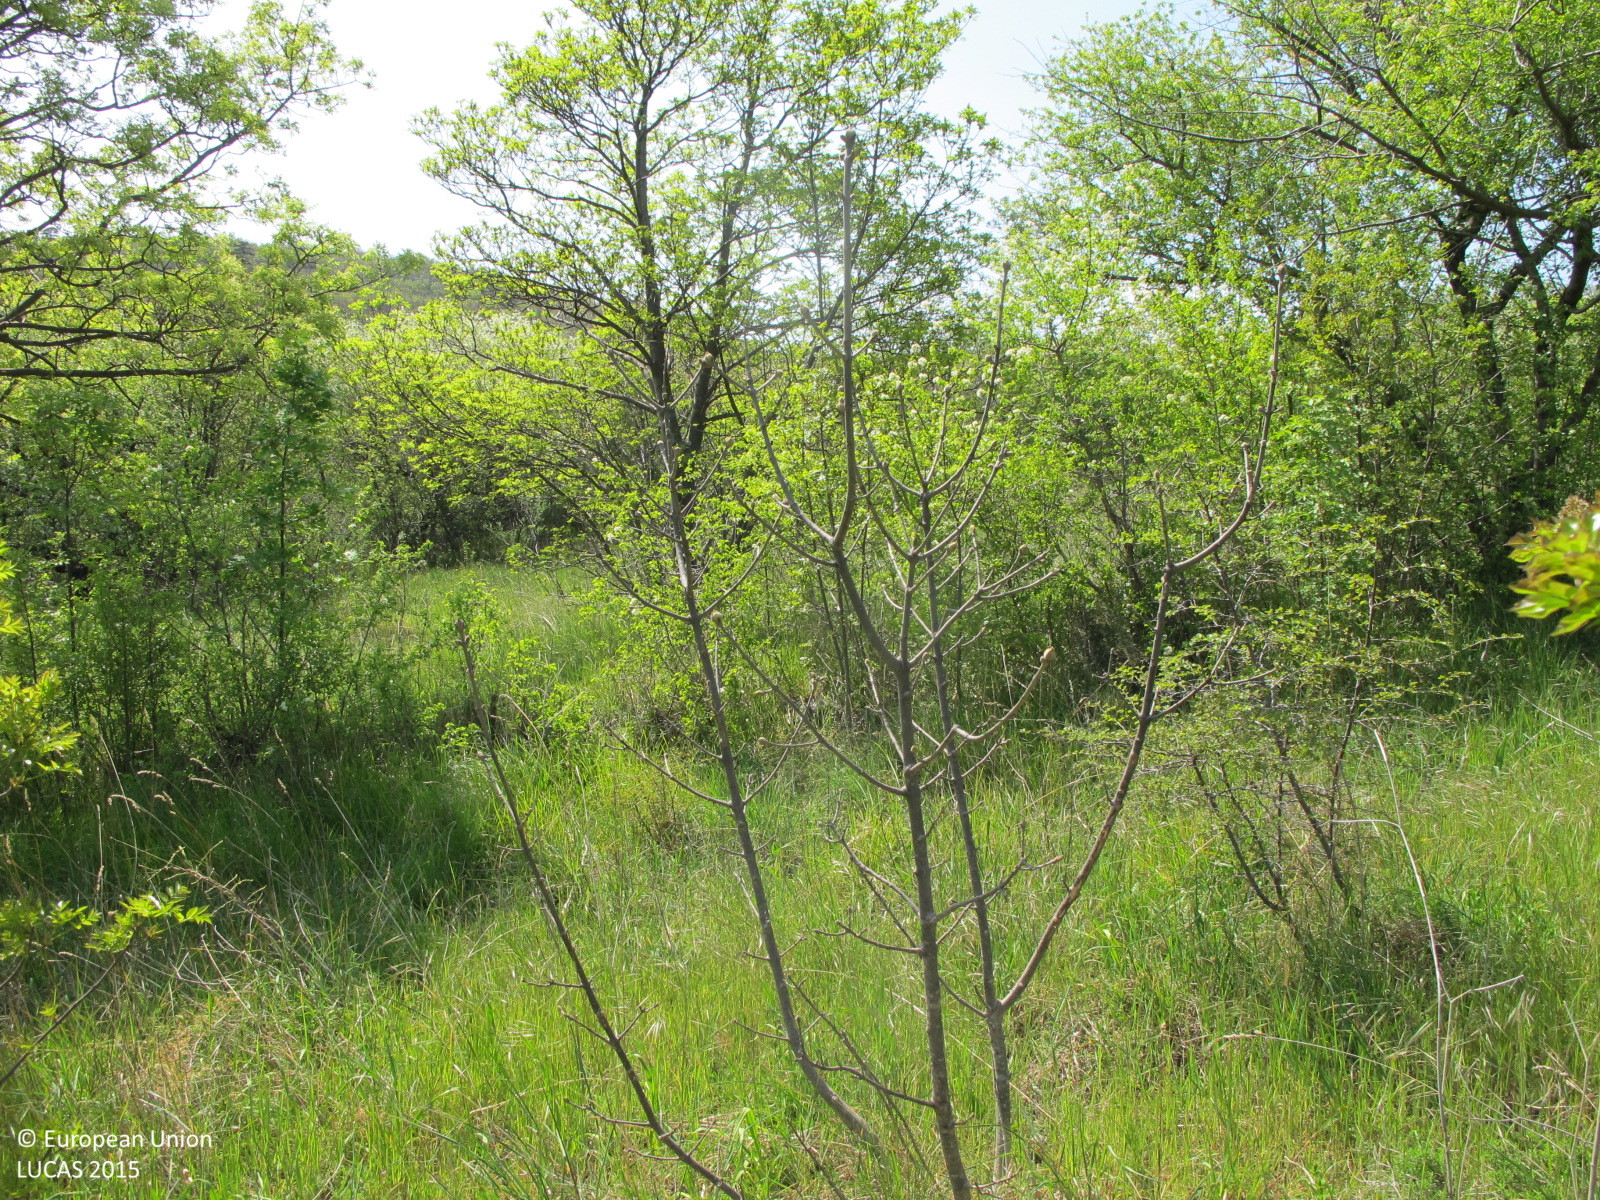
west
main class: Grassland
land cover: Grassland with sparse tree/shrub cover
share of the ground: > 75 %
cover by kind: herbaceous plants 70 %, shrubs 10 %, broadleaved forest trees 5 %
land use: Abandoned areas
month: April
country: HR
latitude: 45.2971
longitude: 14.5729
